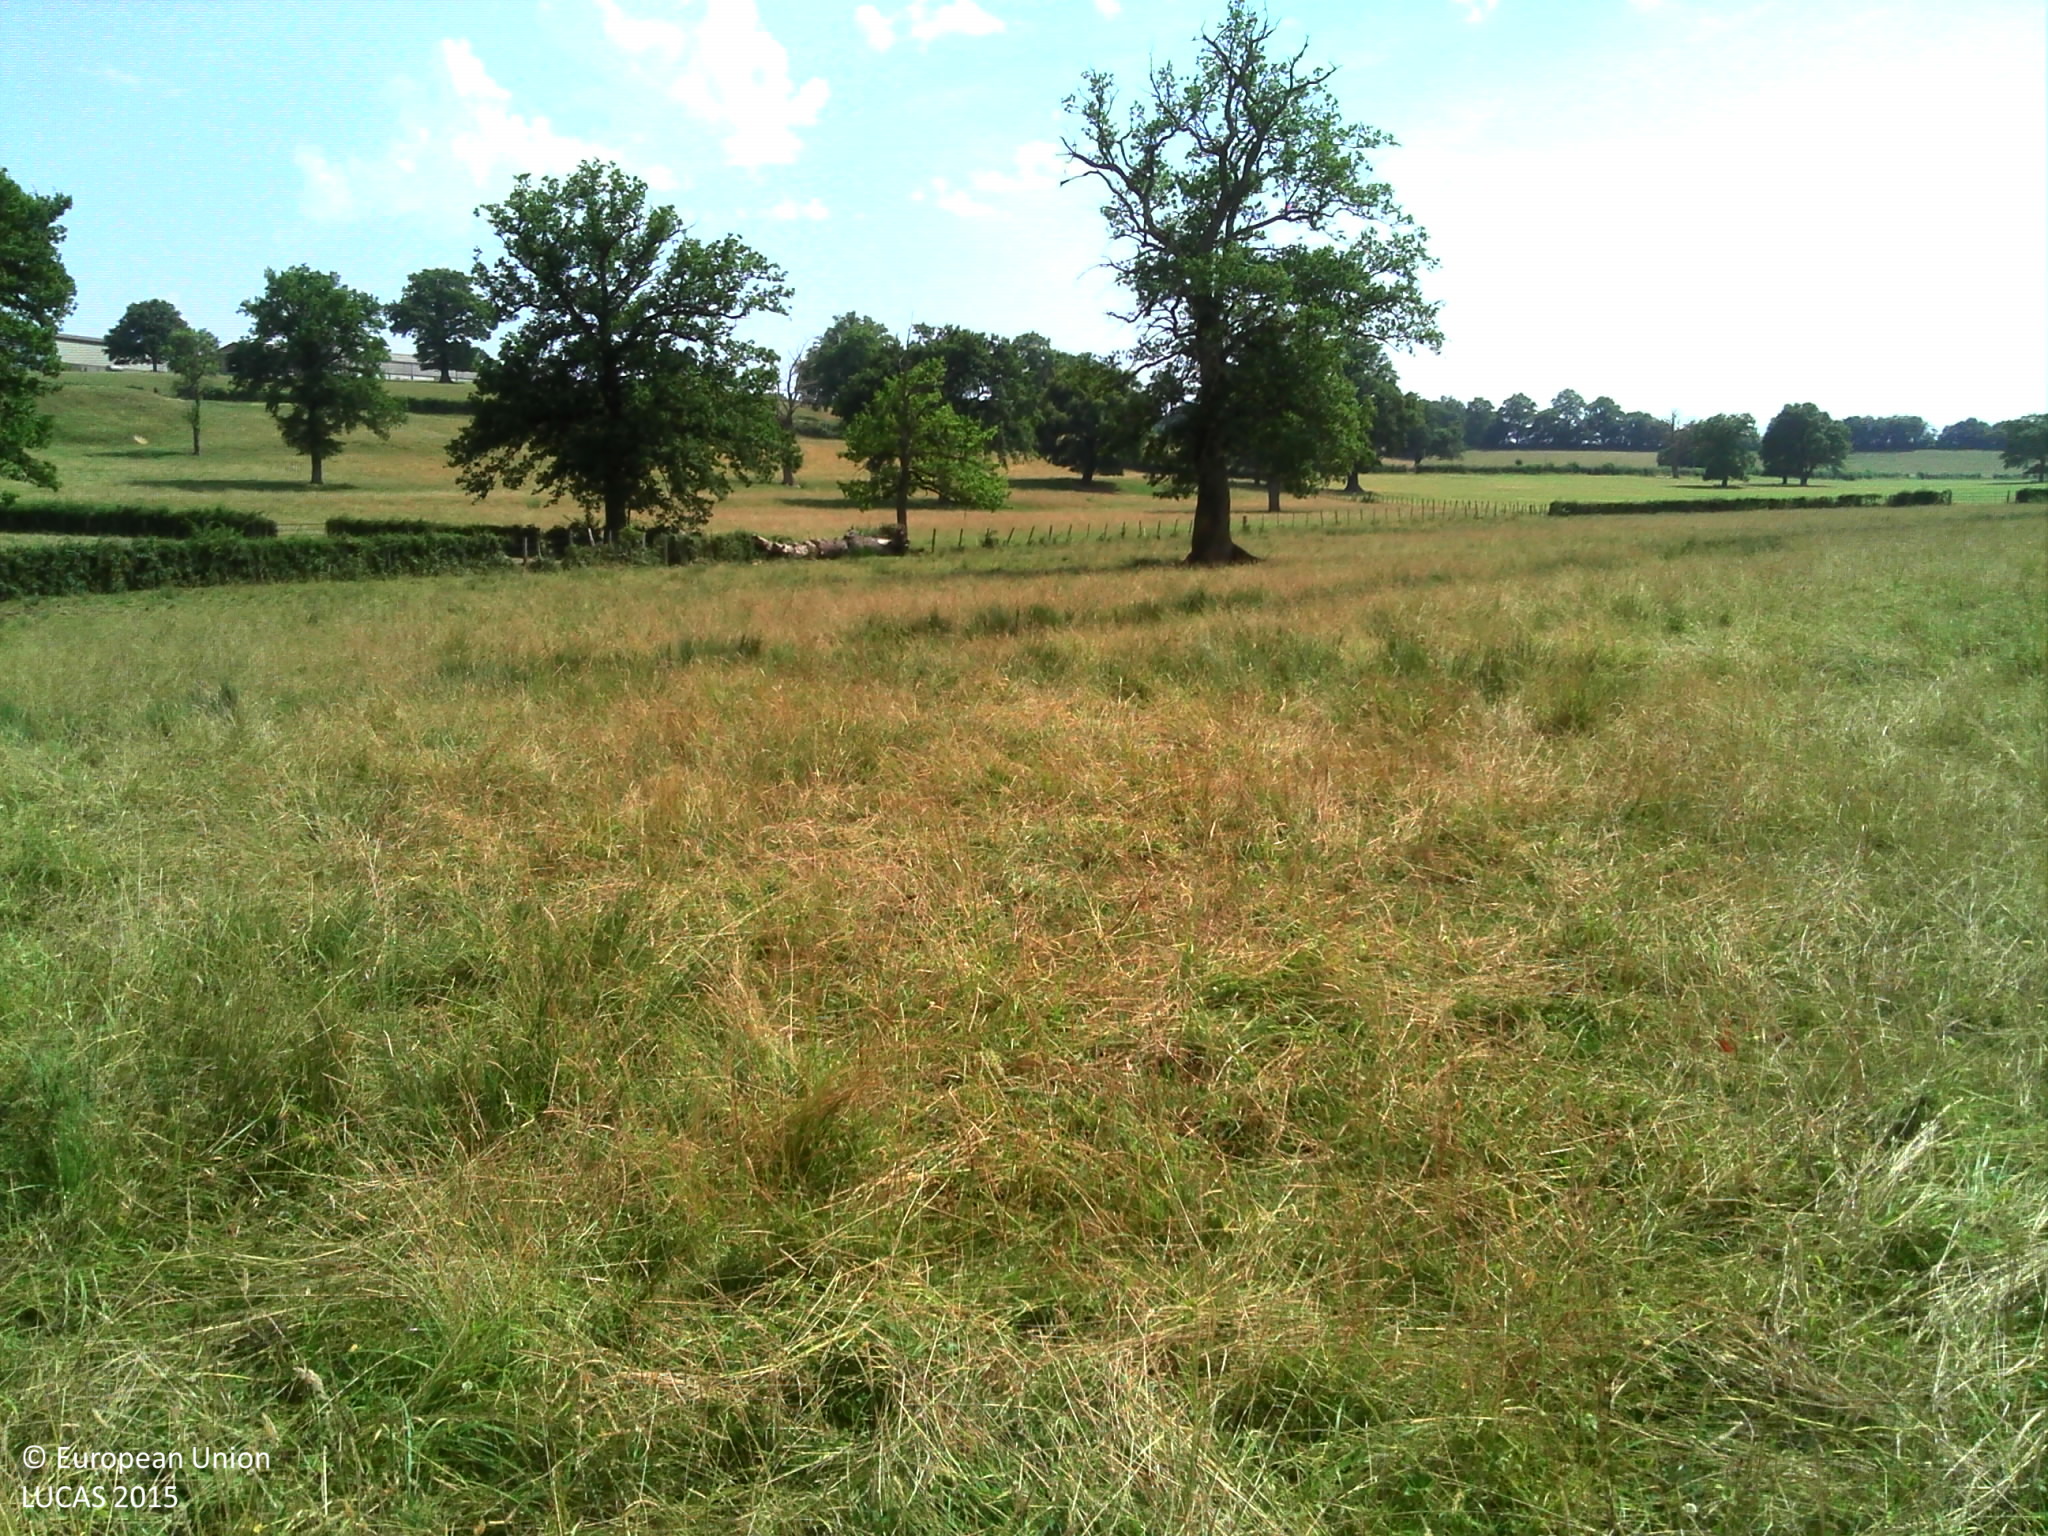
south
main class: Grassland
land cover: Grassland without tree/shrub cover
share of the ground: > 75 %
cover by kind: herbaceous plants 100 %
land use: Agriculture (excluding fallow land and kitchen gardens)
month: July
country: FR
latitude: 47.2215
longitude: 3.5394
